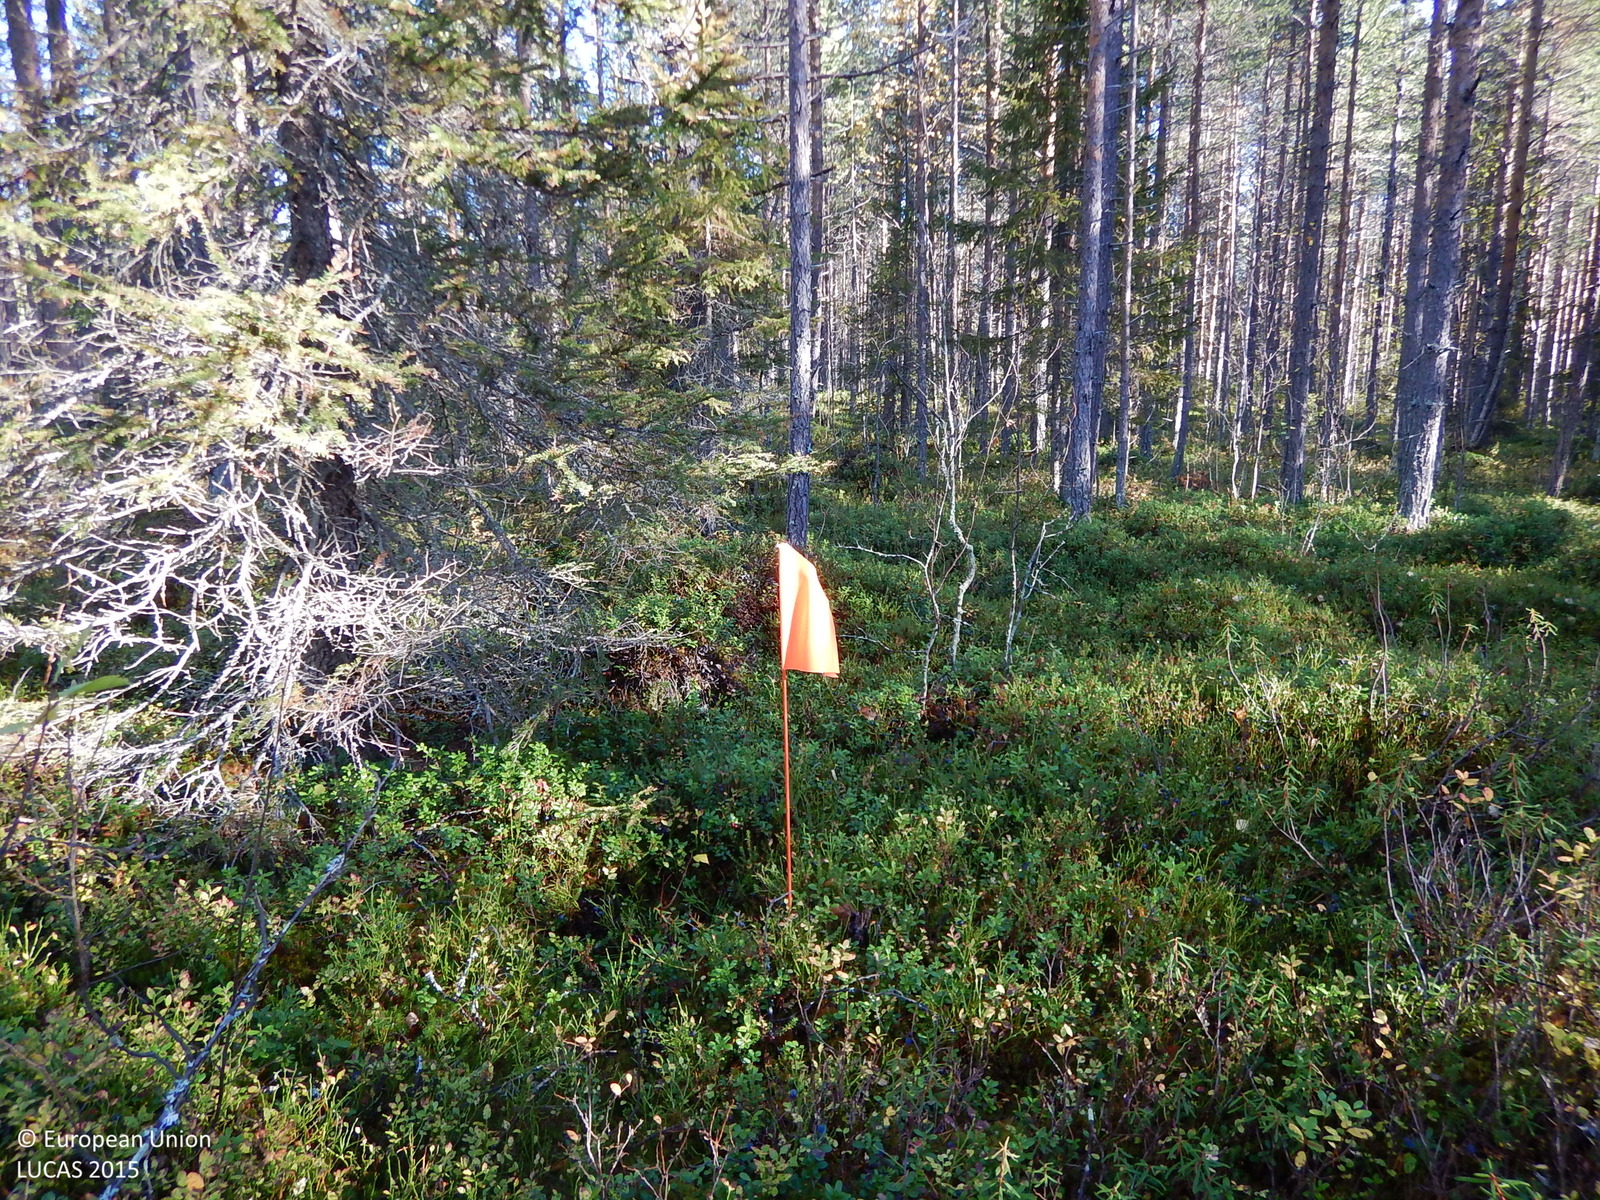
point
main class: Woodland
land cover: Pine dominated mixed woodland
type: boreal forest
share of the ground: 50 - 75 %
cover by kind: coniferous forest trees 40 %, lichens and mosses 20 %, broadleaved forest trees 15 %, shrubs 15 %, herbaceous plants 10 %
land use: Forestry
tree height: > 5 m
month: September
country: SE
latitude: 64.8893
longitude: 19.9172
